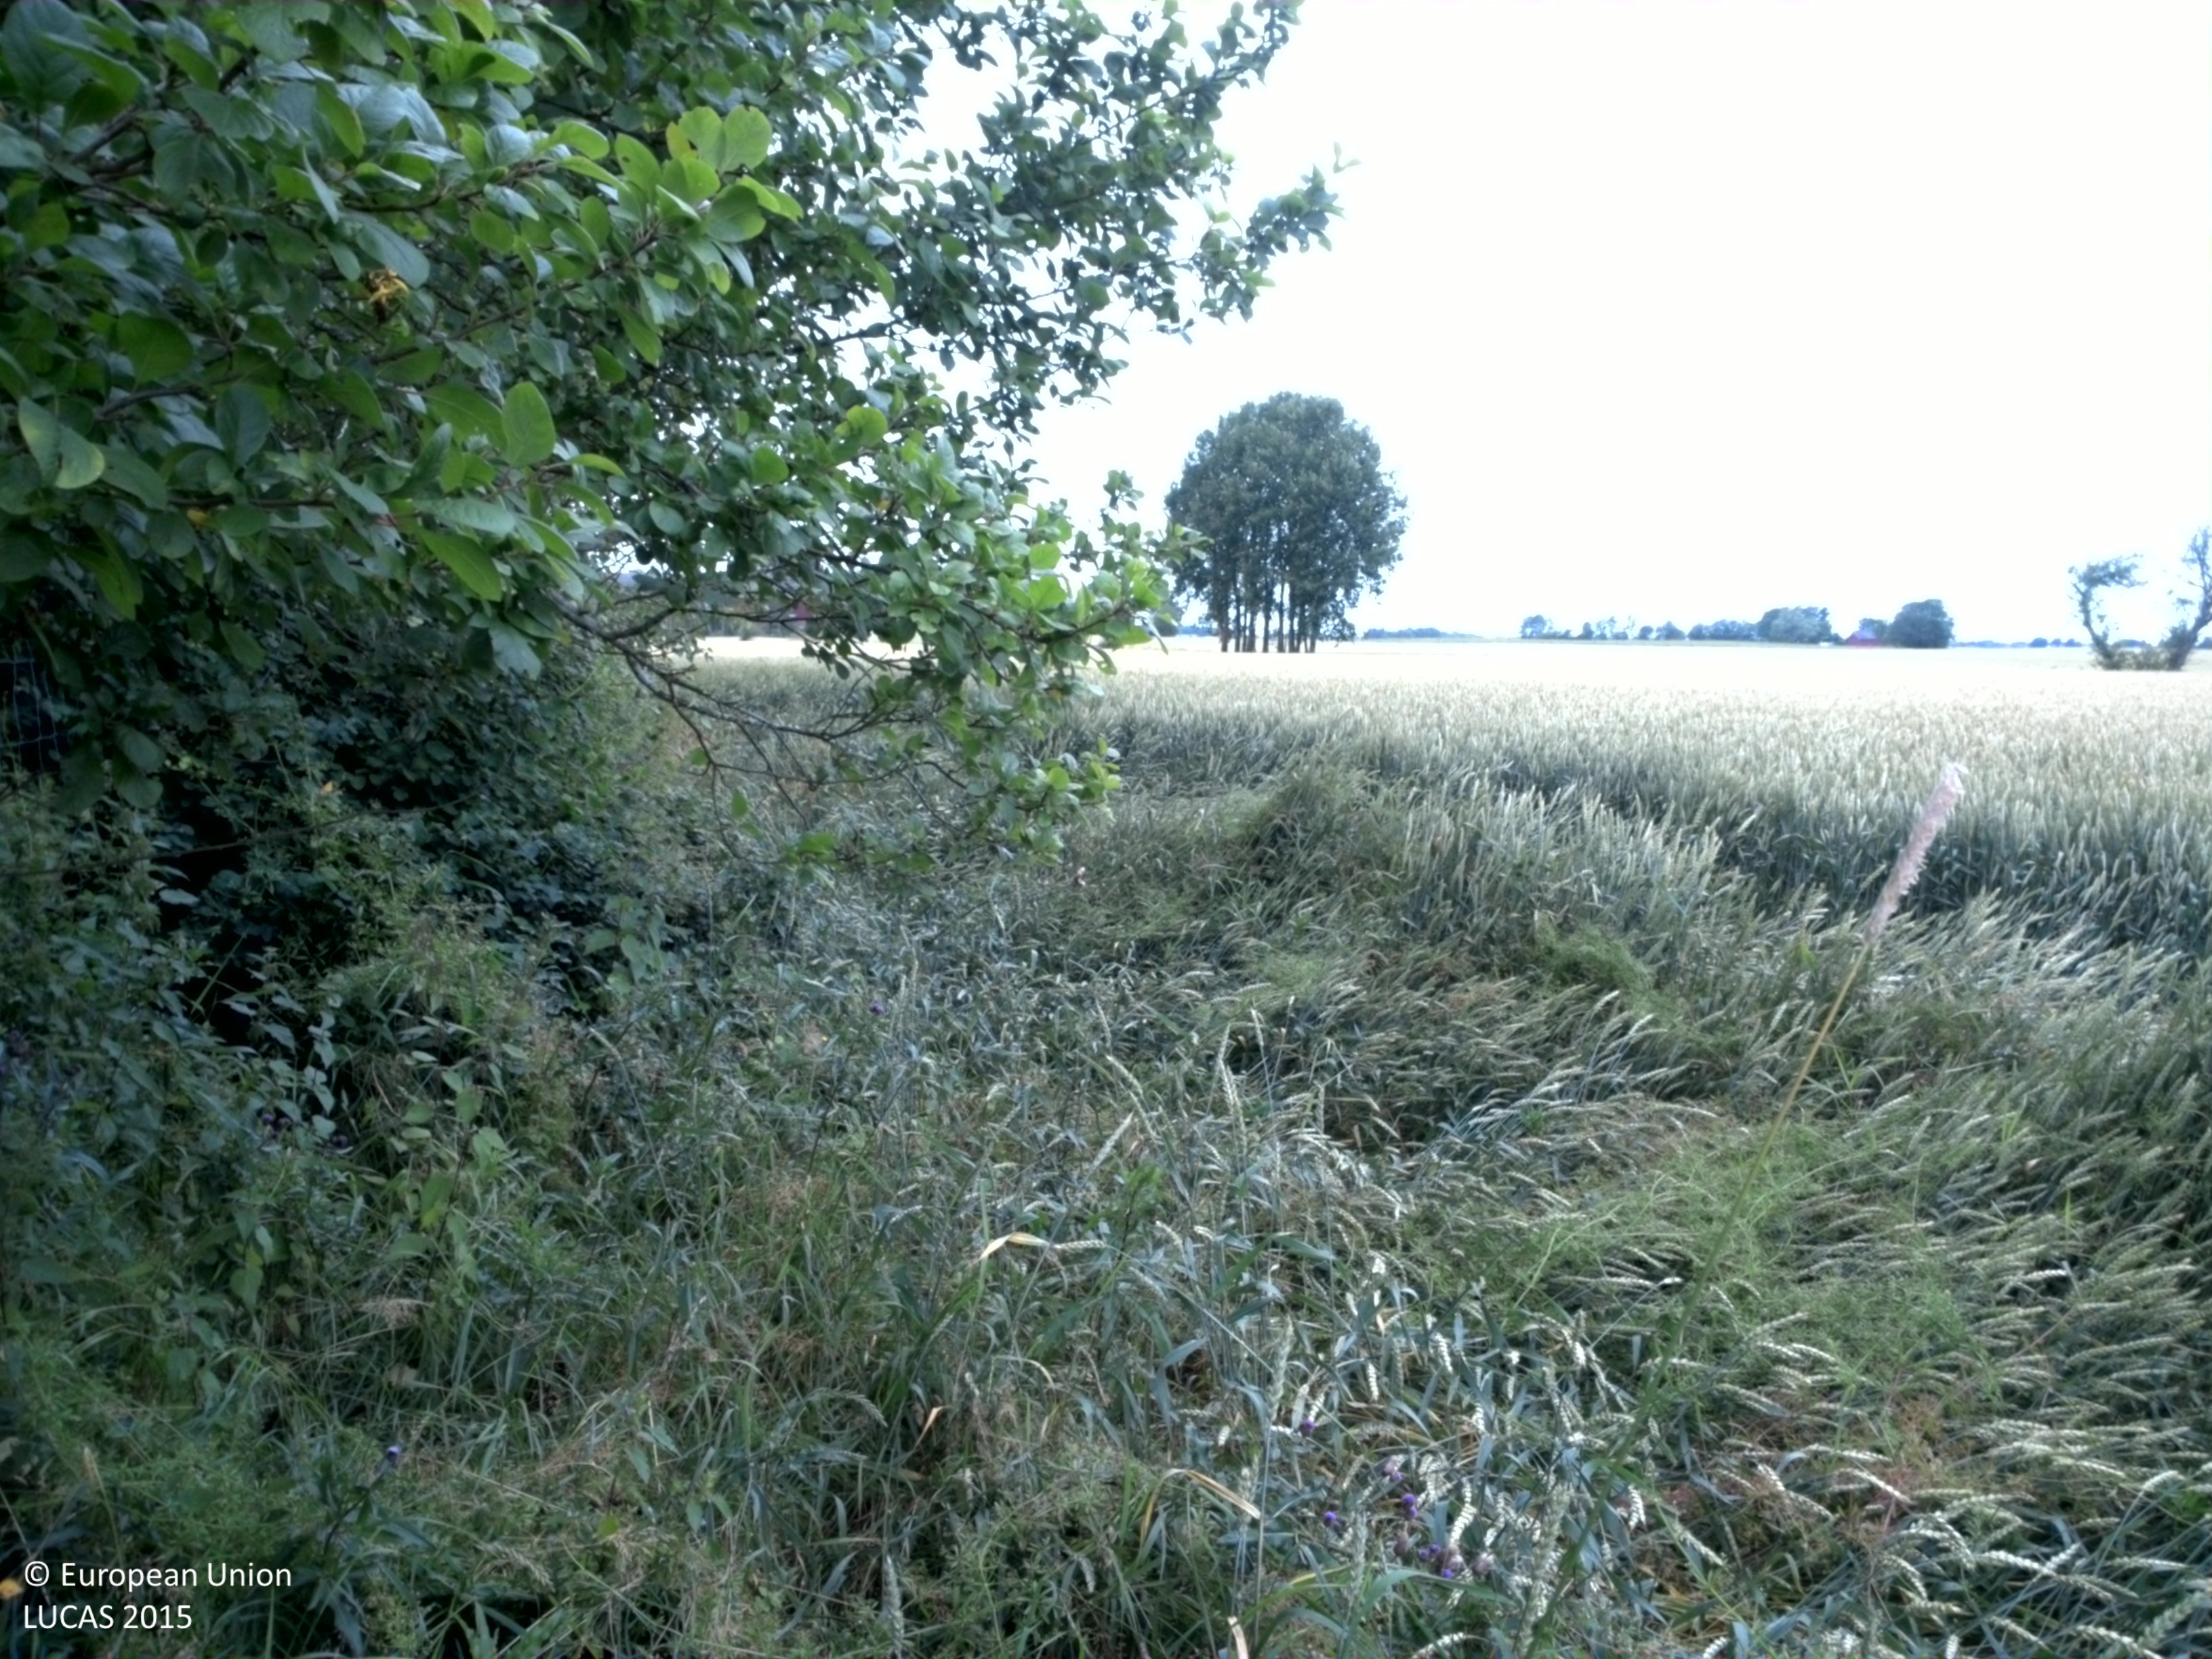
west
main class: Cropland
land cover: Common wheat
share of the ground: > 75 %
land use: Agriculture (excluding fallow land and kitchen gardens)
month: July
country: SE
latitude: 58.3780
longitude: 13.2604
